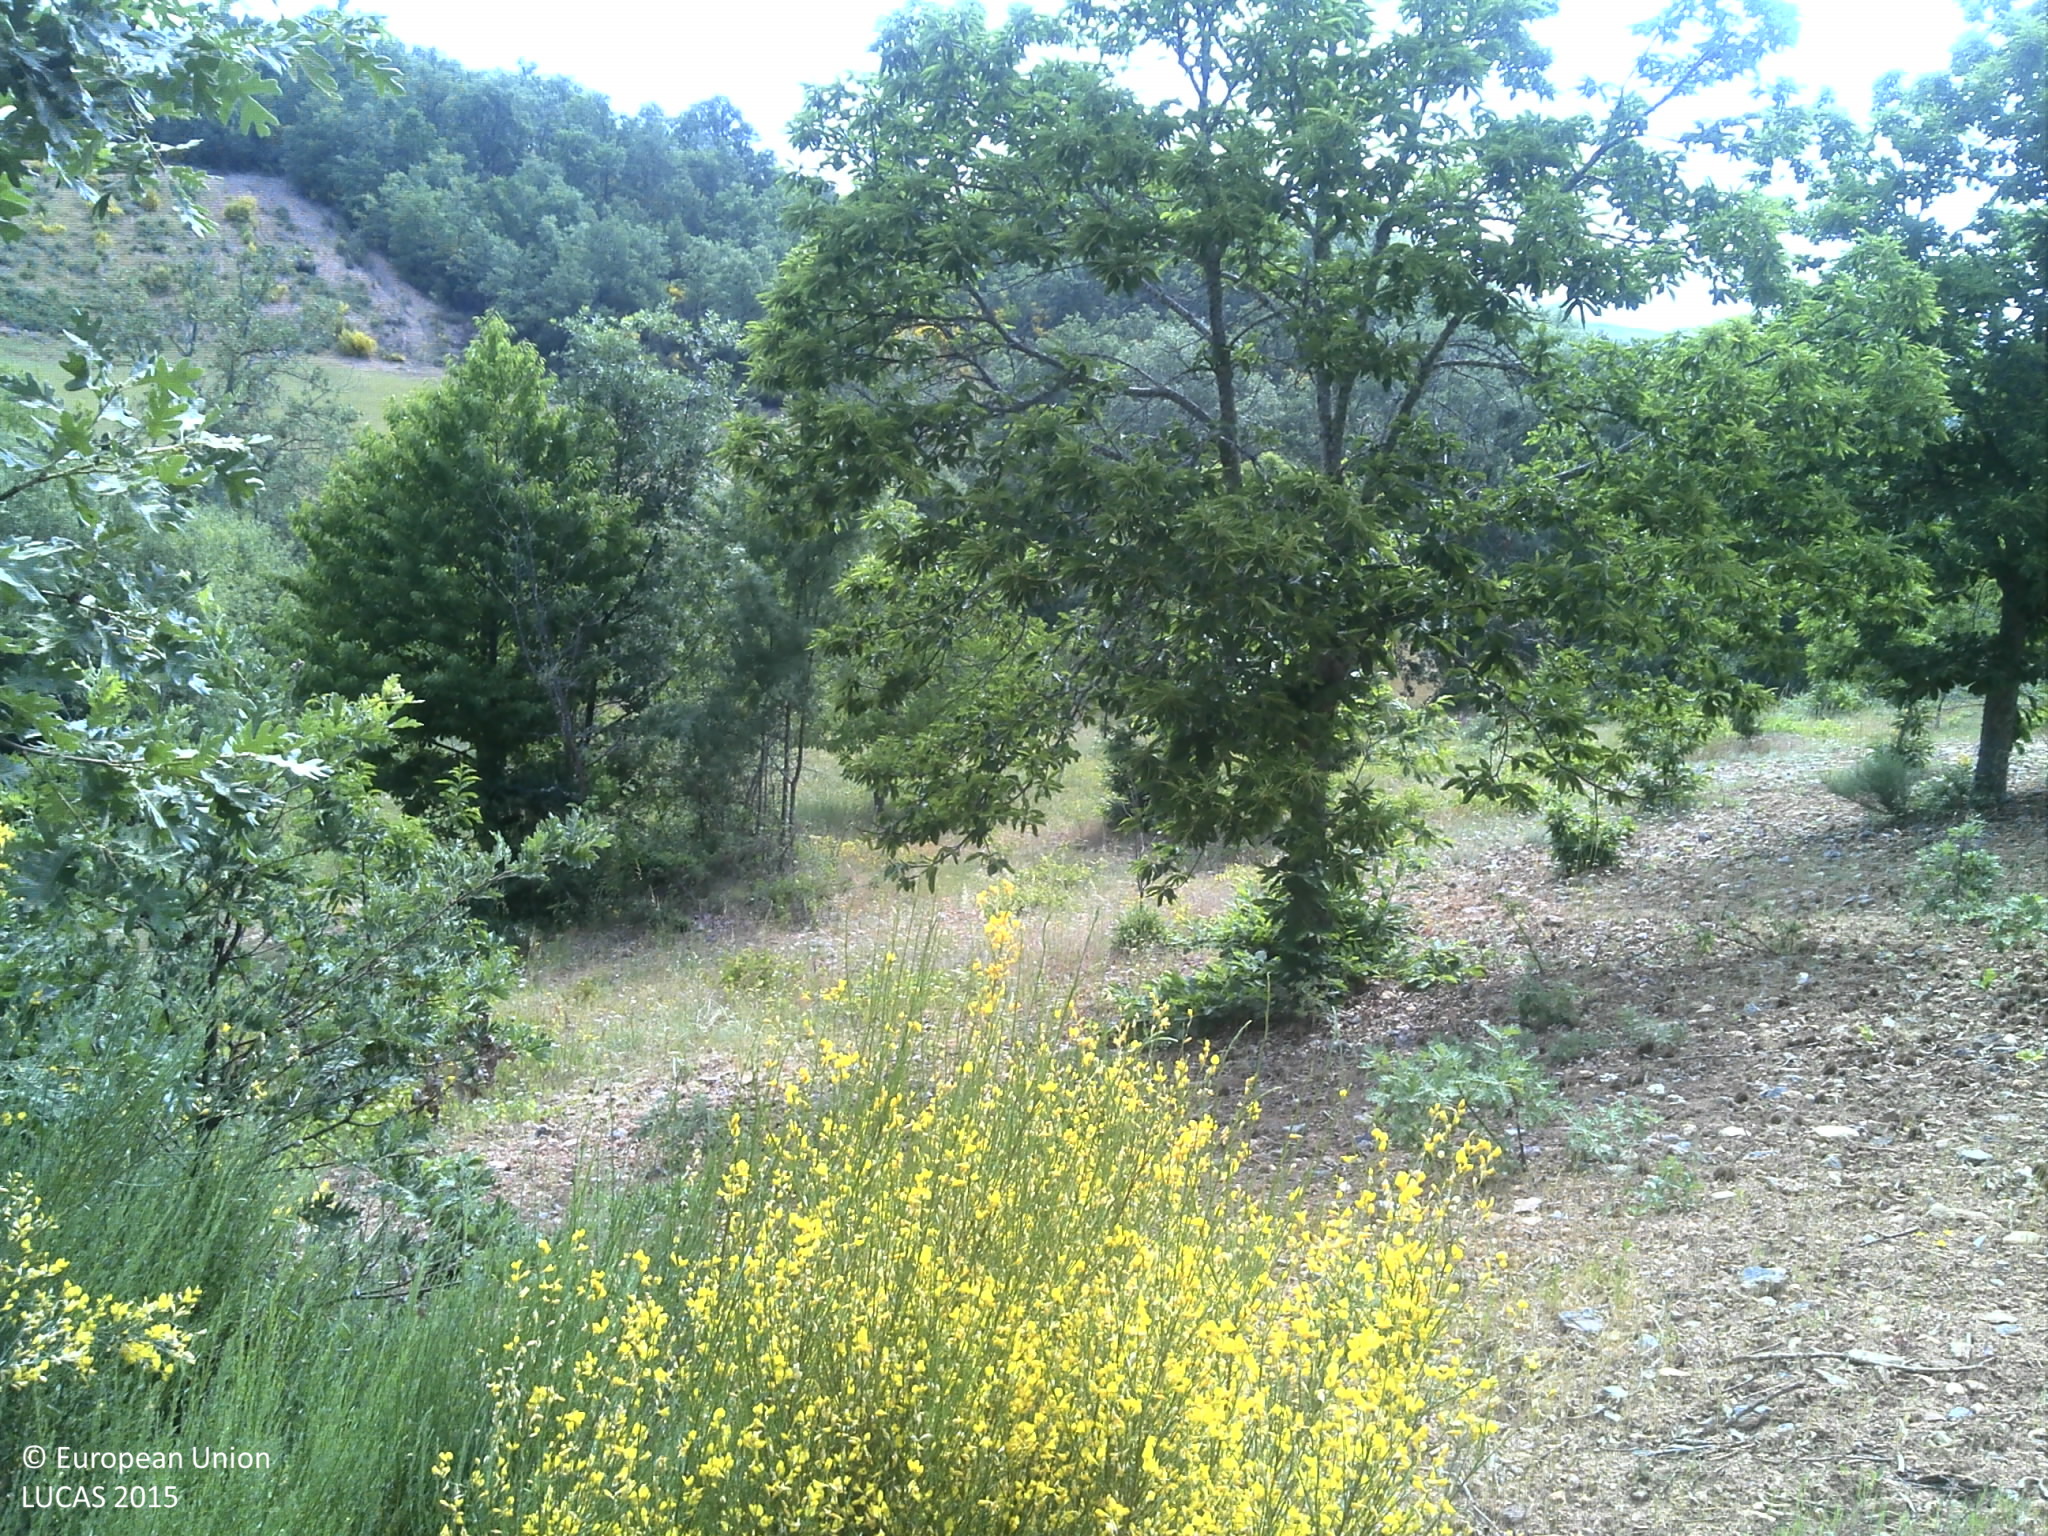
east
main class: Woodland
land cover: Broadleaved woodland
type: acidophilous oak and oak-birch forest
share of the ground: 25 - 50 %
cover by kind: shrubs 75 %, broadleaved forest trees 25 %
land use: Forestry
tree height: > 5 m
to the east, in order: Broadleaved woodland; Shrubland without tree cover; Broadleaved woodland; Nuts trees; Grassland with sparse tree/shrub cover; Shruby margins; Tracks; Grassland without tree/shrub cover; Broadleaved woodland; Shrubland without tree cover; Shrubland with sparse tree cover; Broadleaved woodland
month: June
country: PT
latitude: 41.8047
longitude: -6.6111
